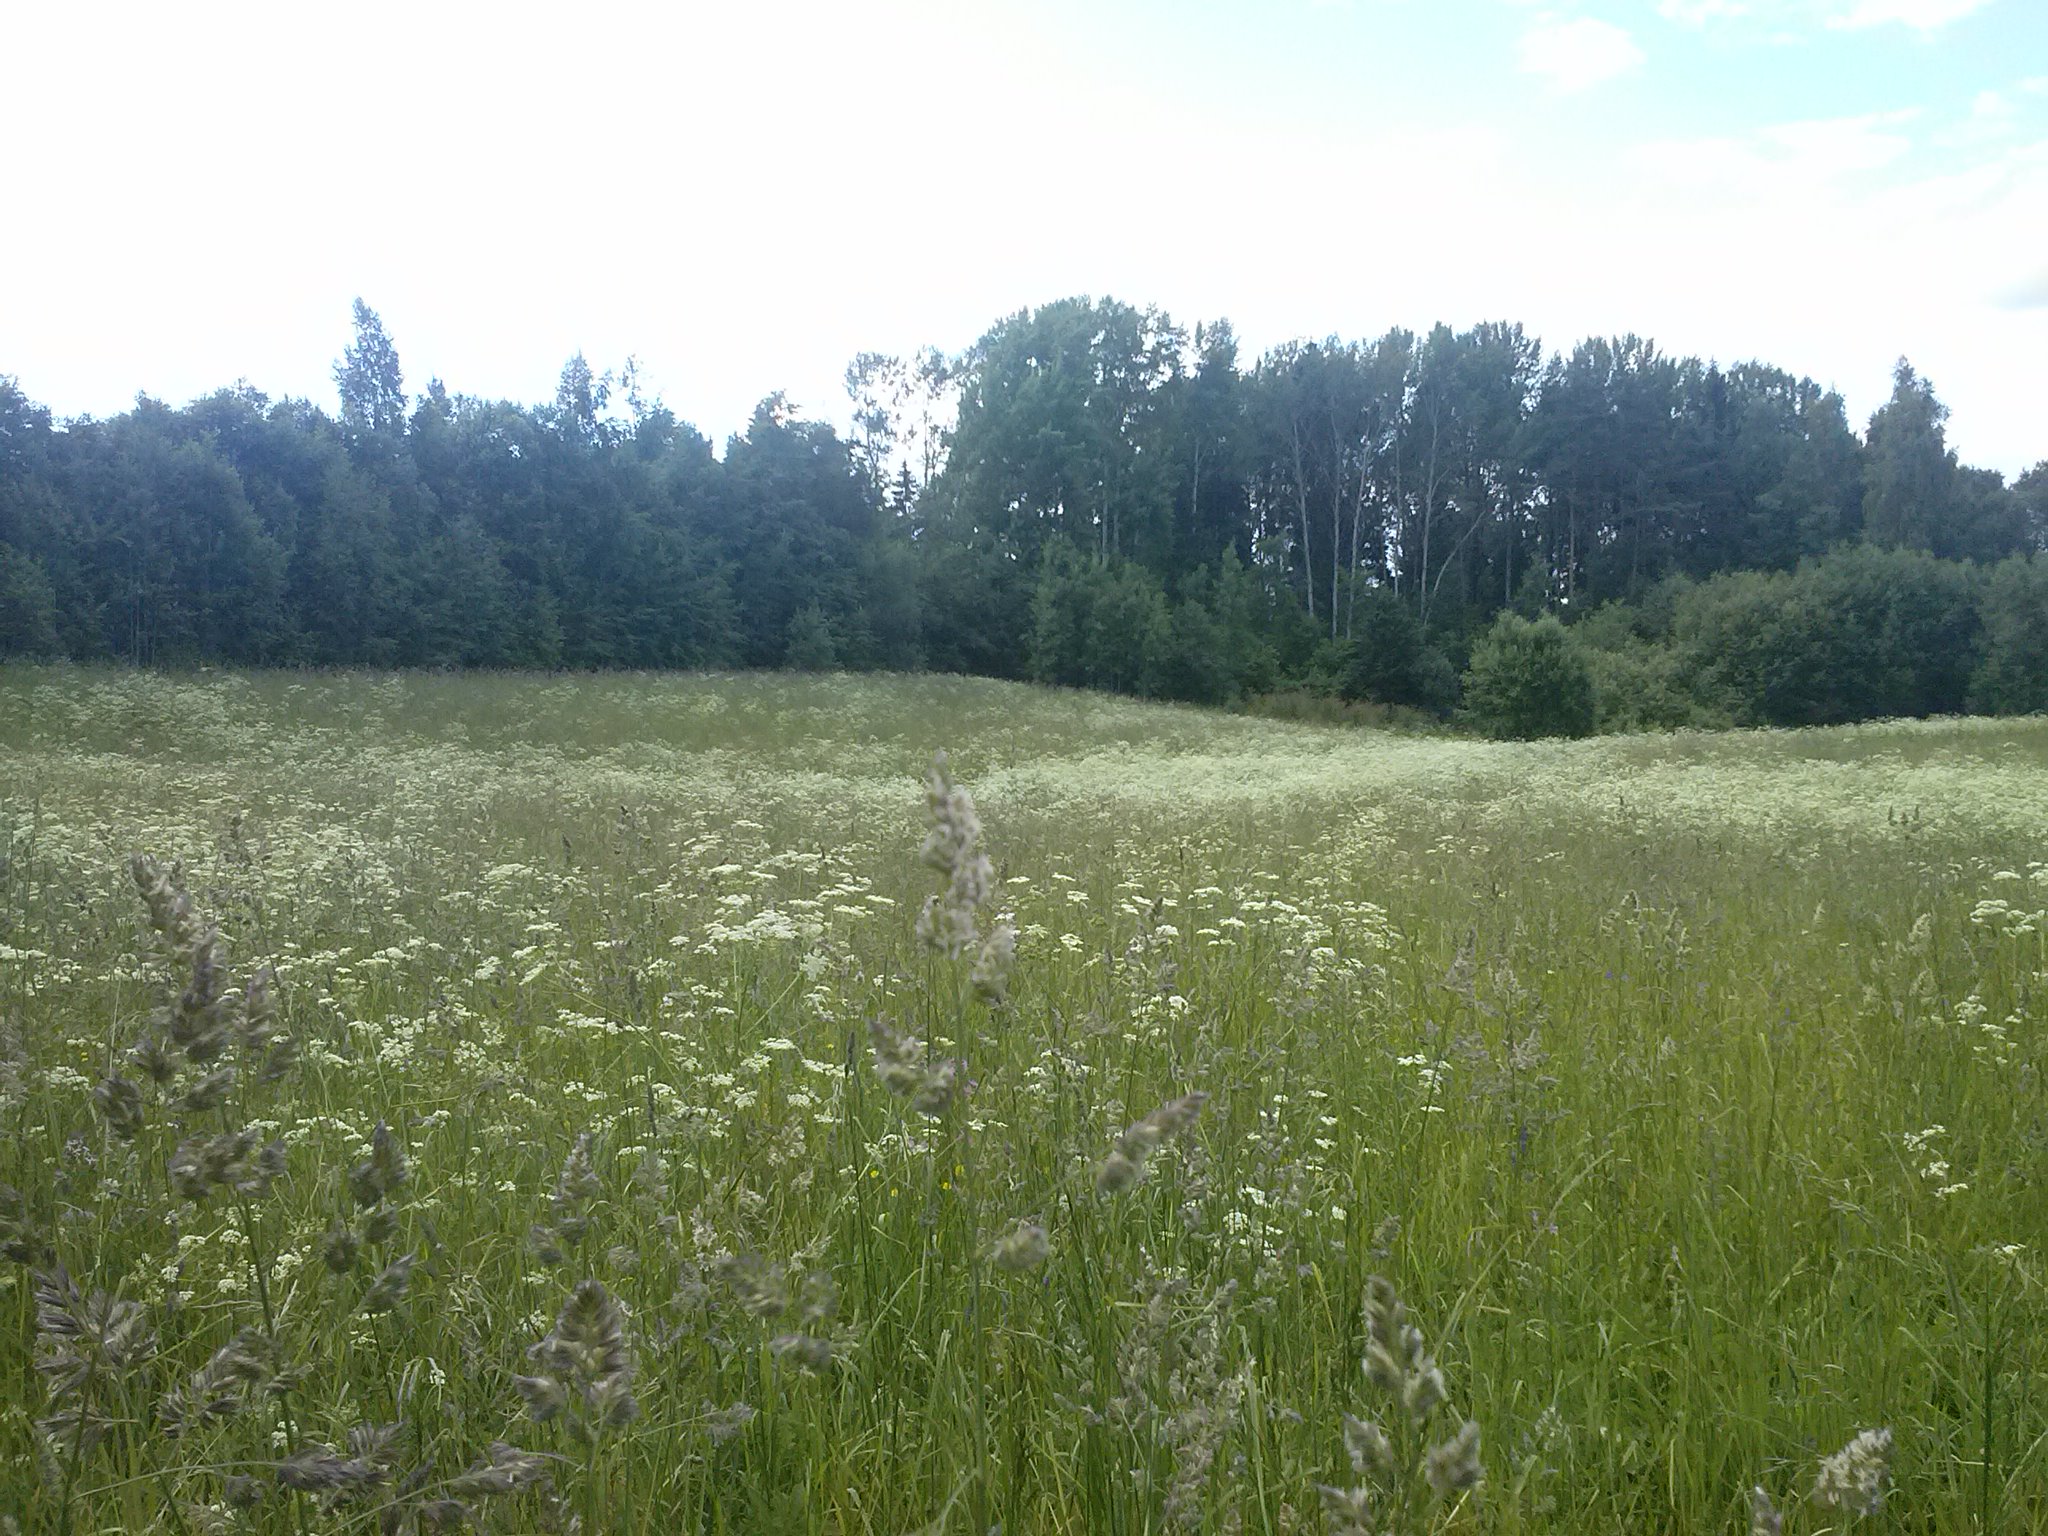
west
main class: Grassland
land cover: Grassland without tree/shrub cover
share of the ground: > 75 %
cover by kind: herbaceous plants 100 %
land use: Agriculture (excluding fallow land and kitchen gardens)
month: June
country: LV
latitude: 56.5003
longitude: 27.7827
